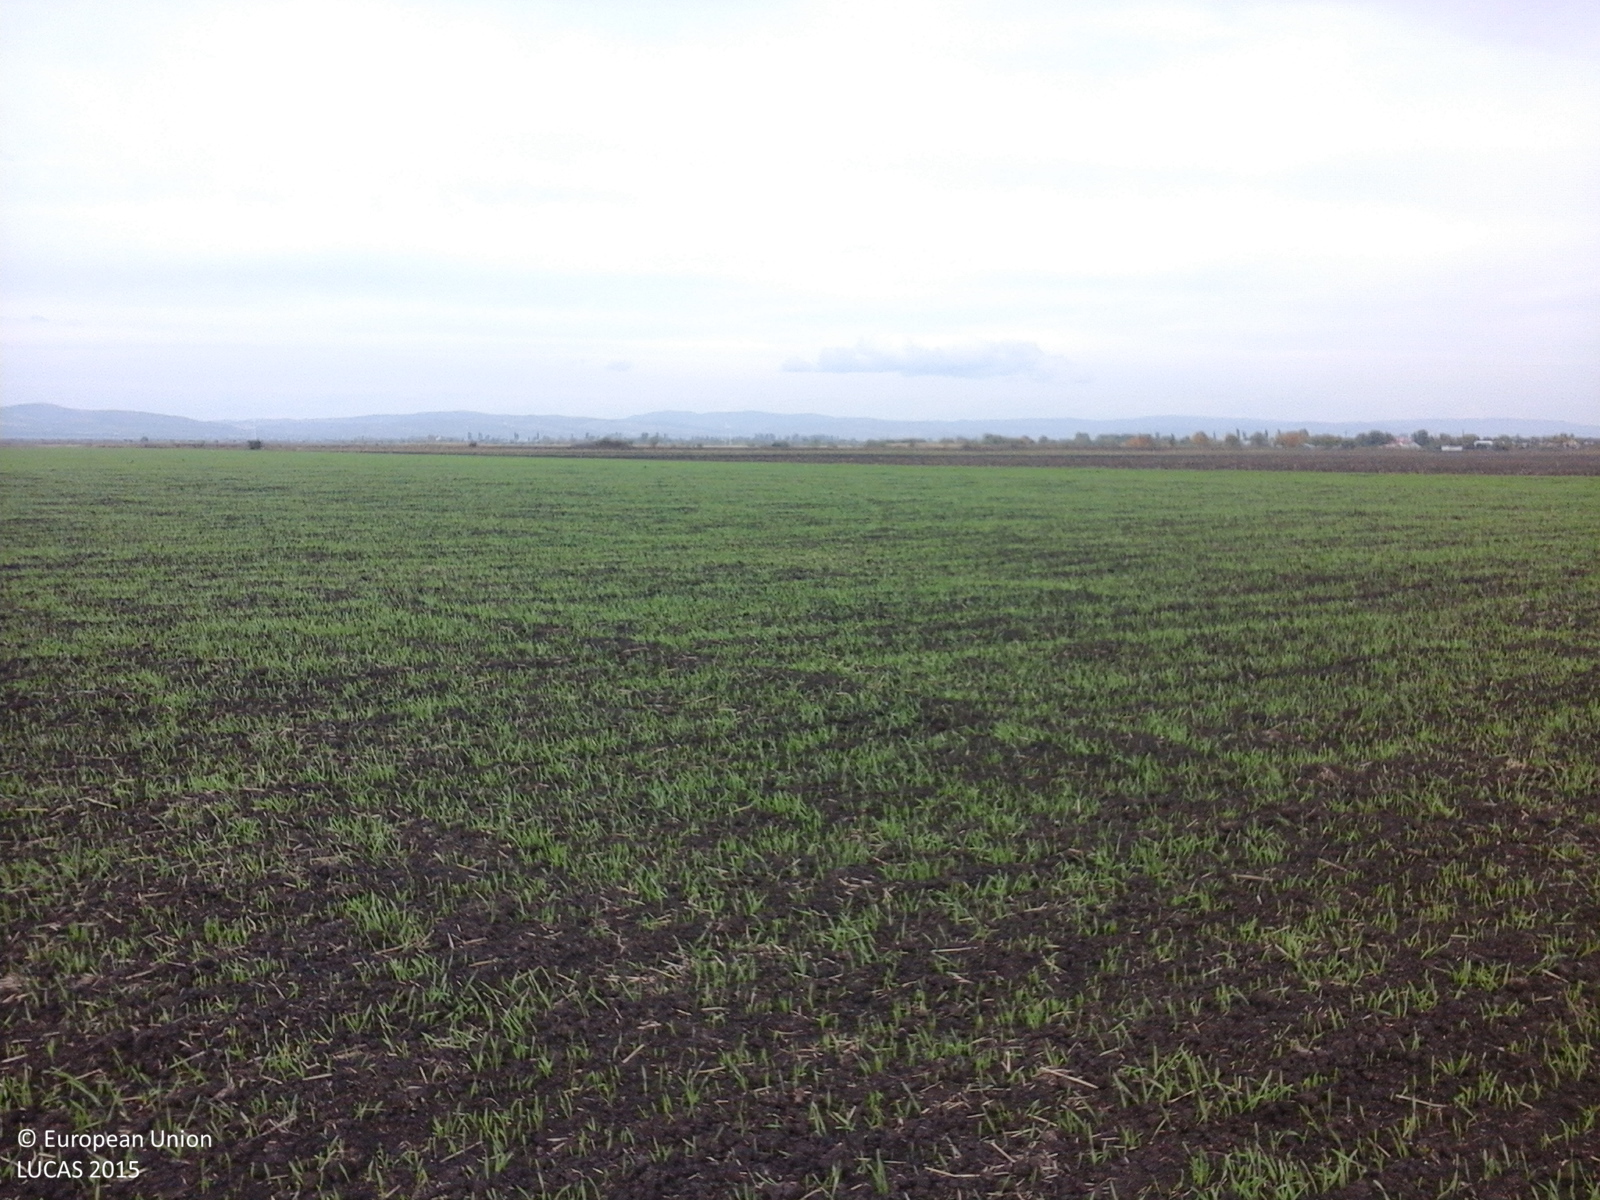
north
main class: Cropland
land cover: Common wheat
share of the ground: 50 - 75 %
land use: Agriculture (excluding fallow land and kitchen gardens)
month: October
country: RO
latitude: 44.9355
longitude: 26.3486
